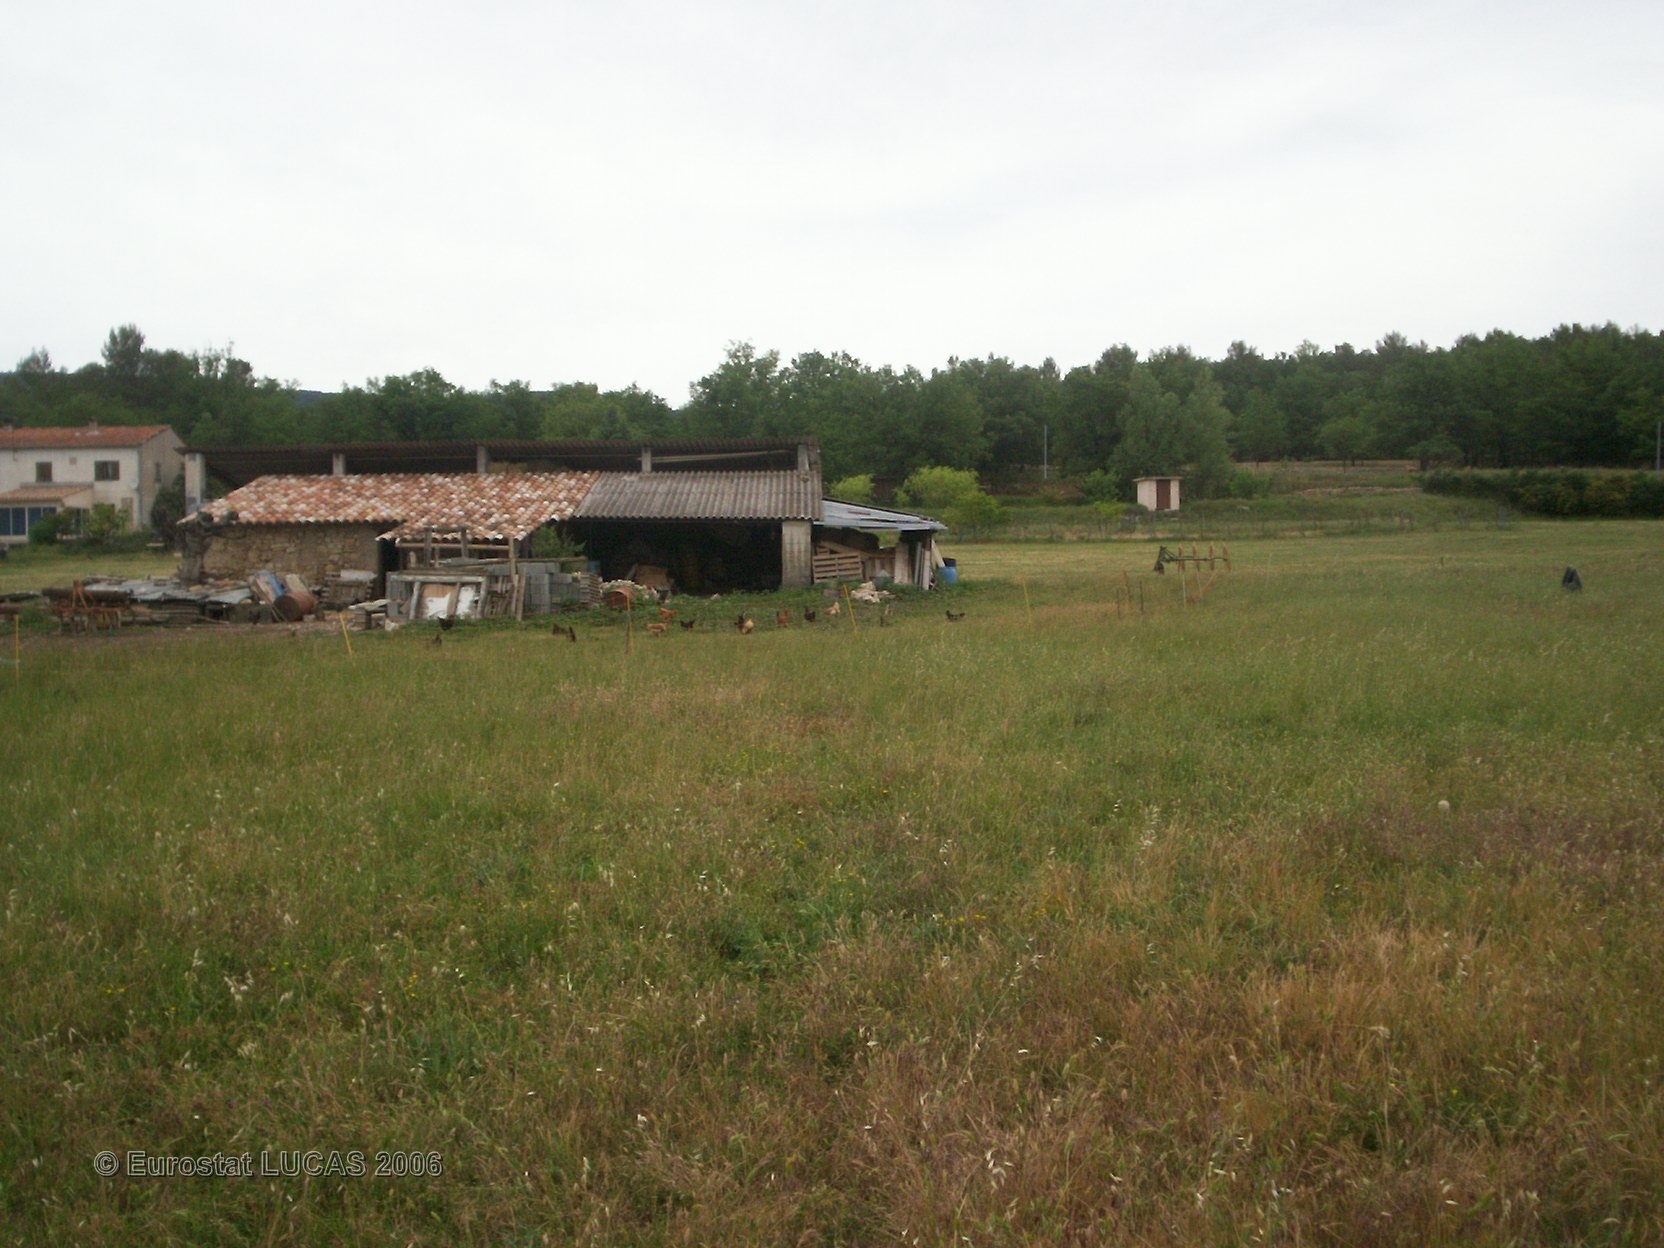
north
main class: Grassland
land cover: Grassland without tree/shrub cover
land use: Agriculture (excluding fallow land and kitchen gardens)
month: May
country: FR
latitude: 43.5711
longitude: 6.5537
